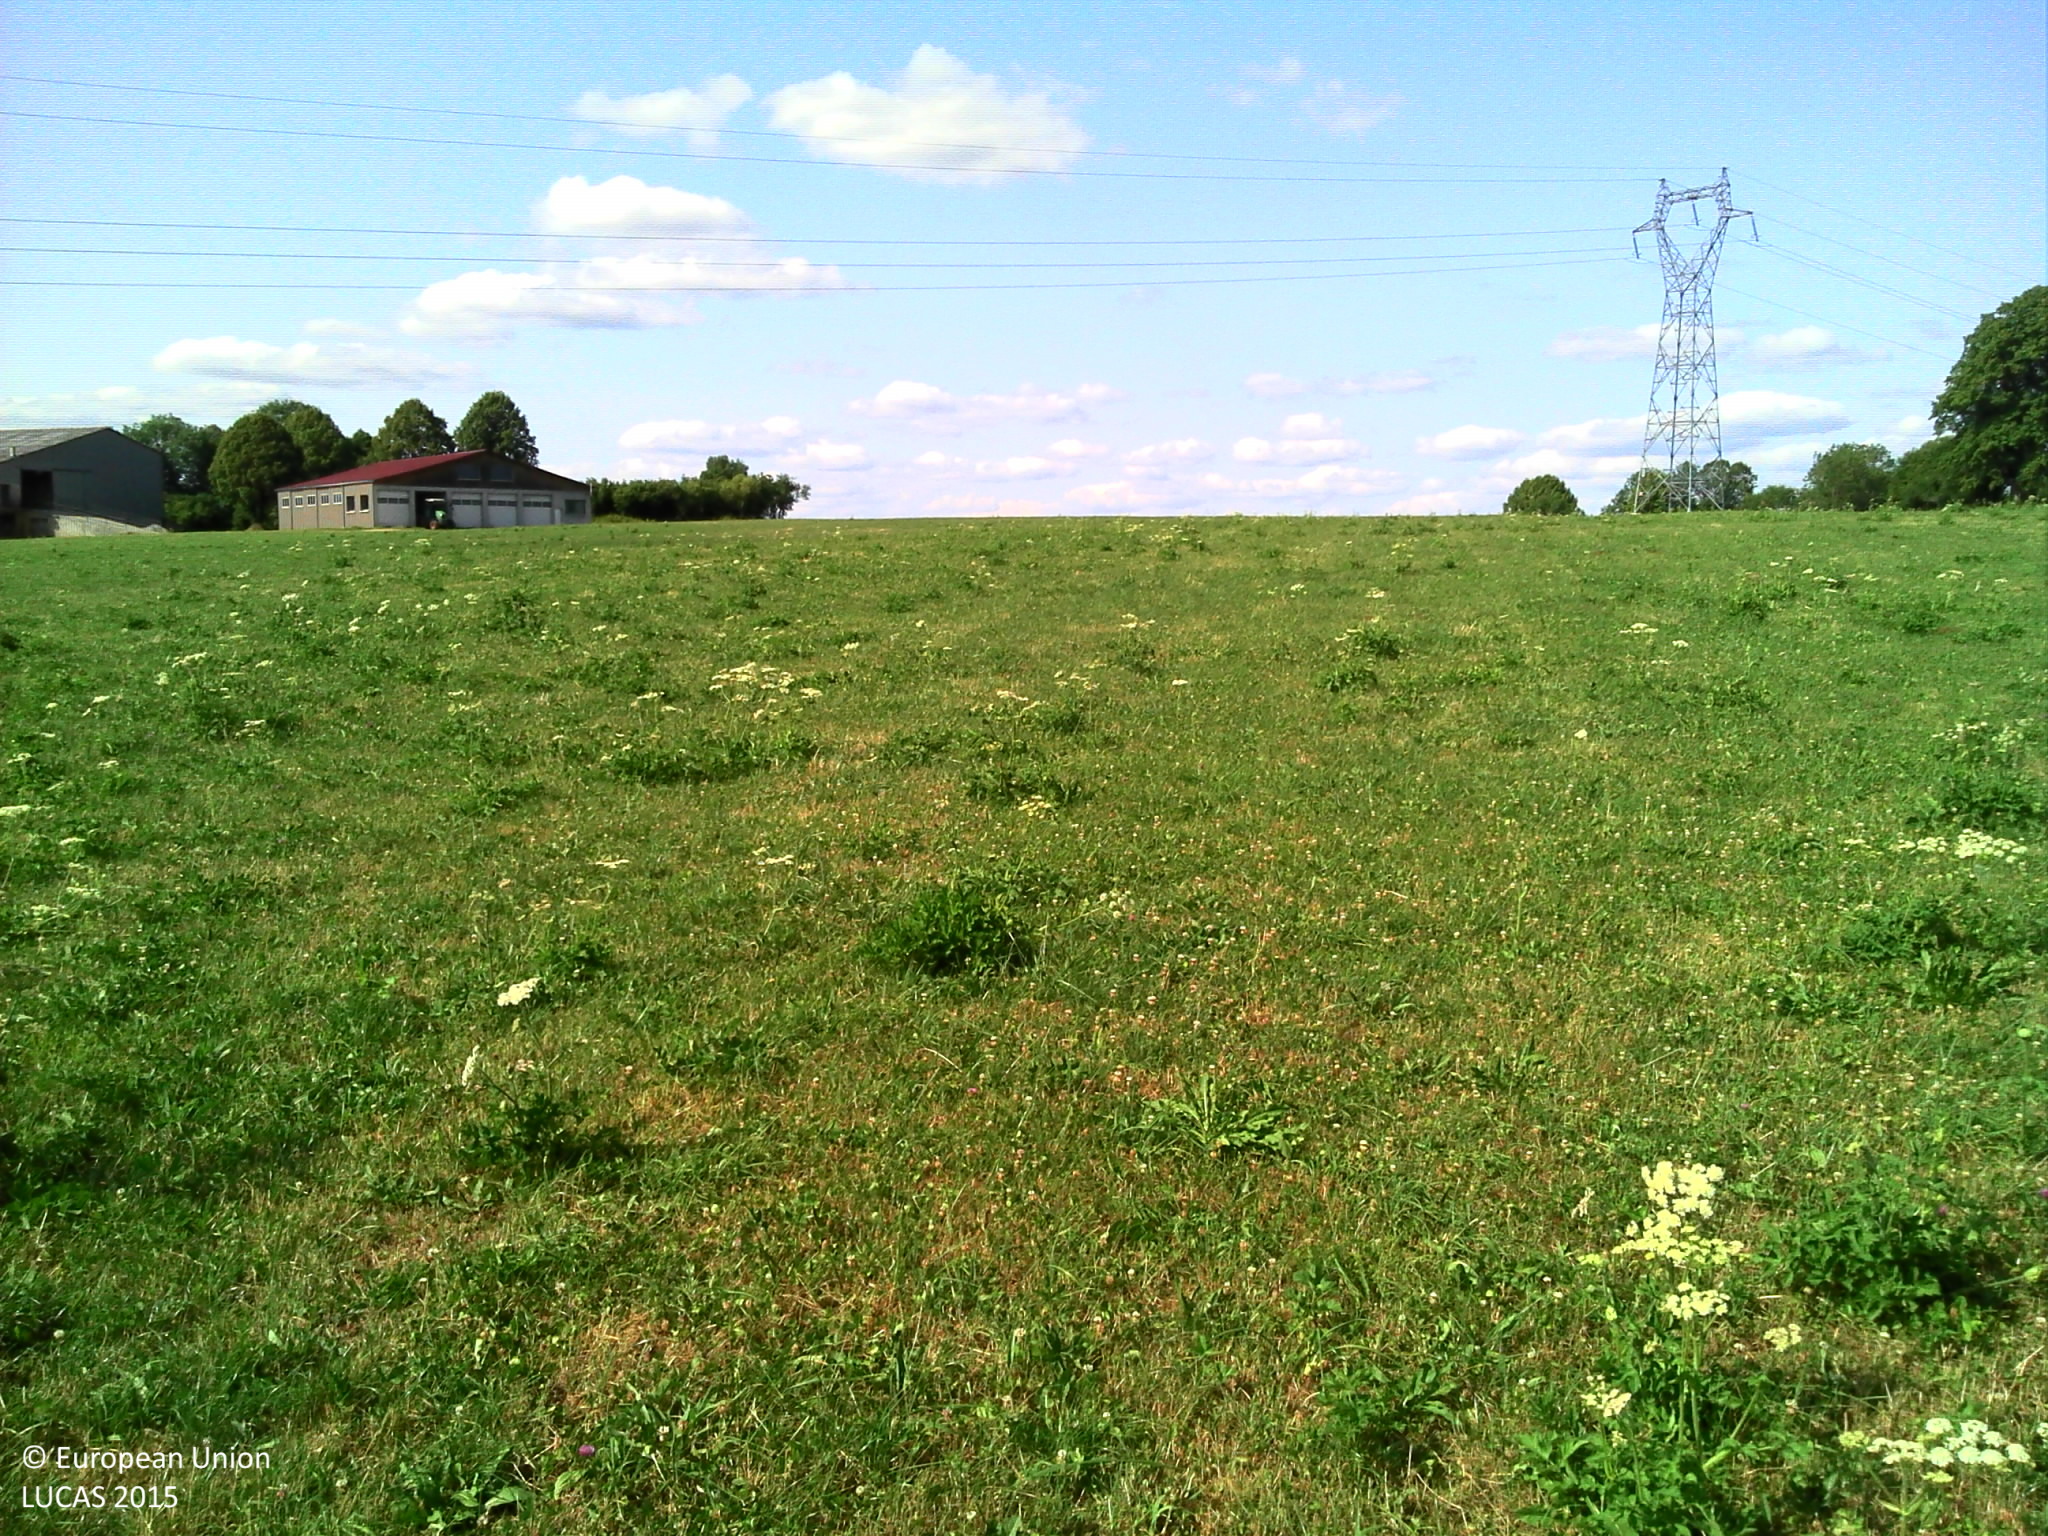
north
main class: Grassland
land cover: Grassland without tree/shrub cover
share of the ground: > 75 %
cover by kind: herbaceous plants 100 %
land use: Agriculture (excluding fallow land and kitchen gardens)
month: July
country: FR
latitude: 46.8015
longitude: 6.0585
